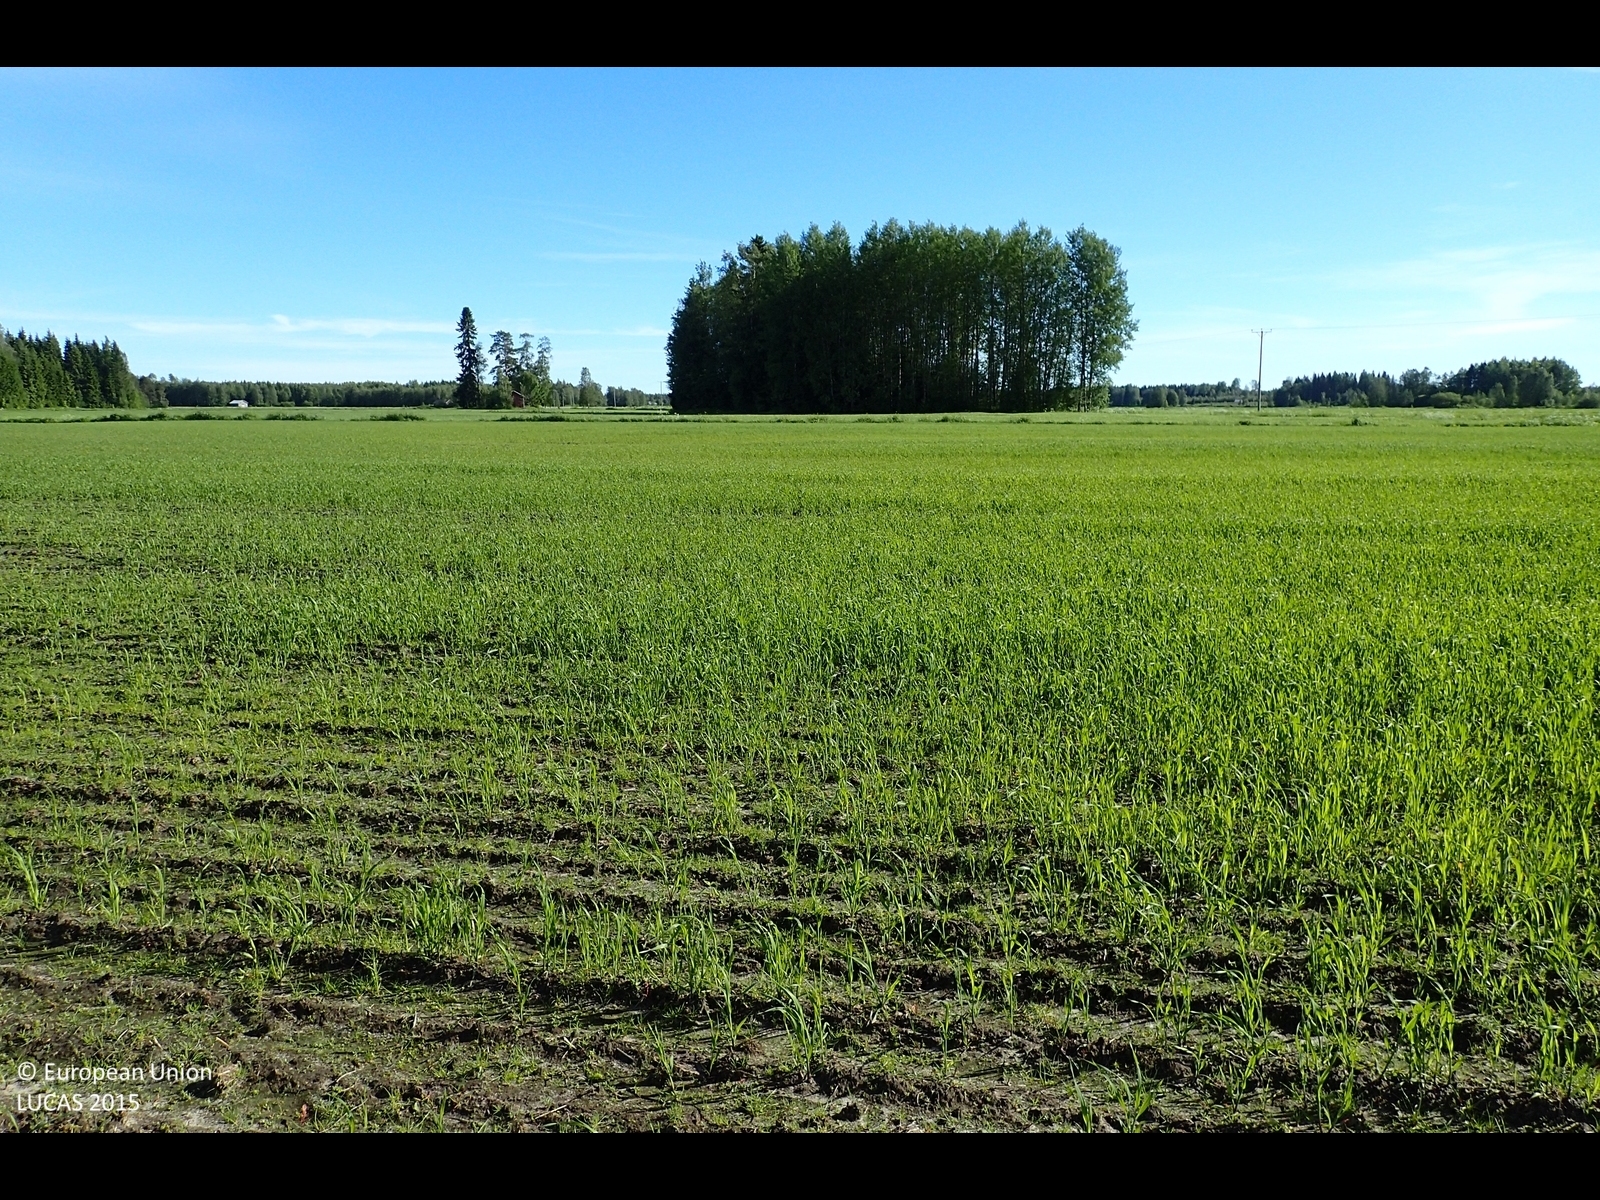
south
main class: Cropland
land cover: Oats
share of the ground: > 75 %
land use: Agriculture (excluding fallow land and kitchen gardens)
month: July
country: FI
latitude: 62.5775
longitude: 21.6640
